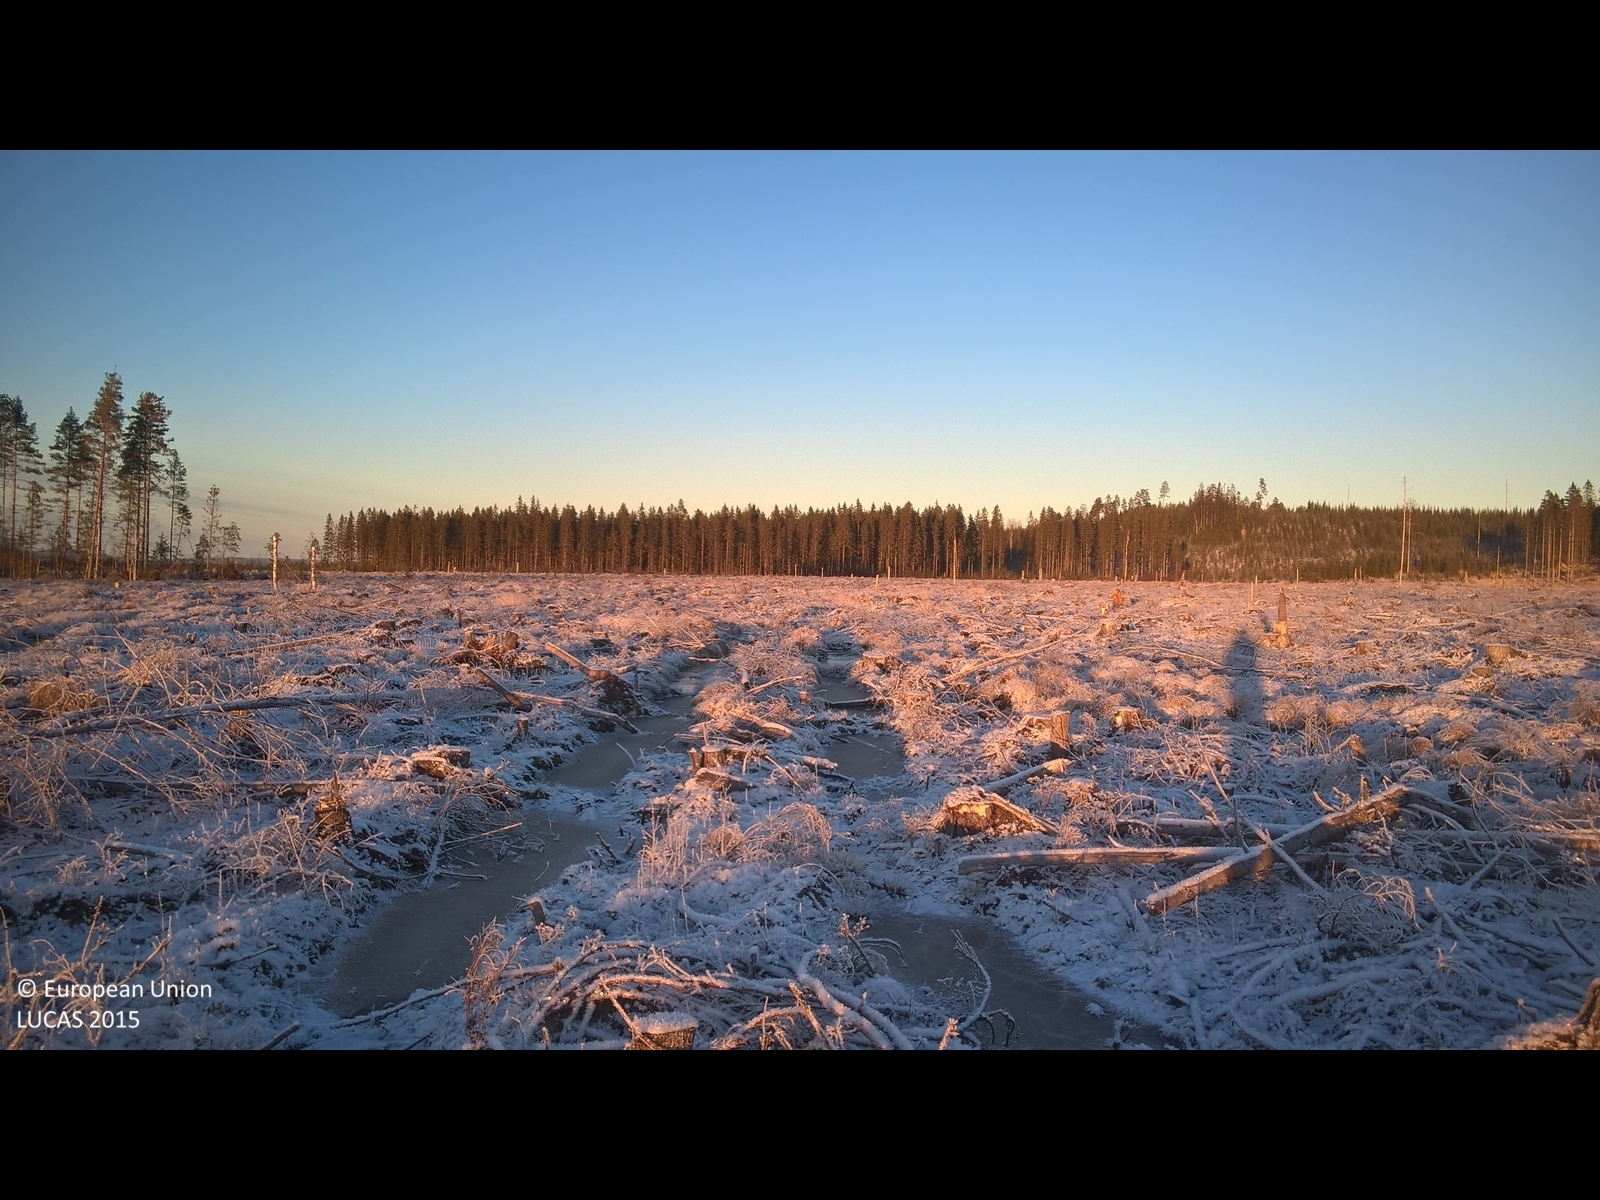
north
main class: Grassland
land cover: Grassland with sparse tree/shrub cover
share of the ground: 10 - 25 %
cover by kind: lichens and mosses 75 %, herbaceous plants 15 %, coniferous forest trees 5 %, shrubs 5 %
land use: Forestry
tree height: > 5 m
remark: Clear cut
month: November
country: SE
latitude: 60.3881
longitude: 14.2162
